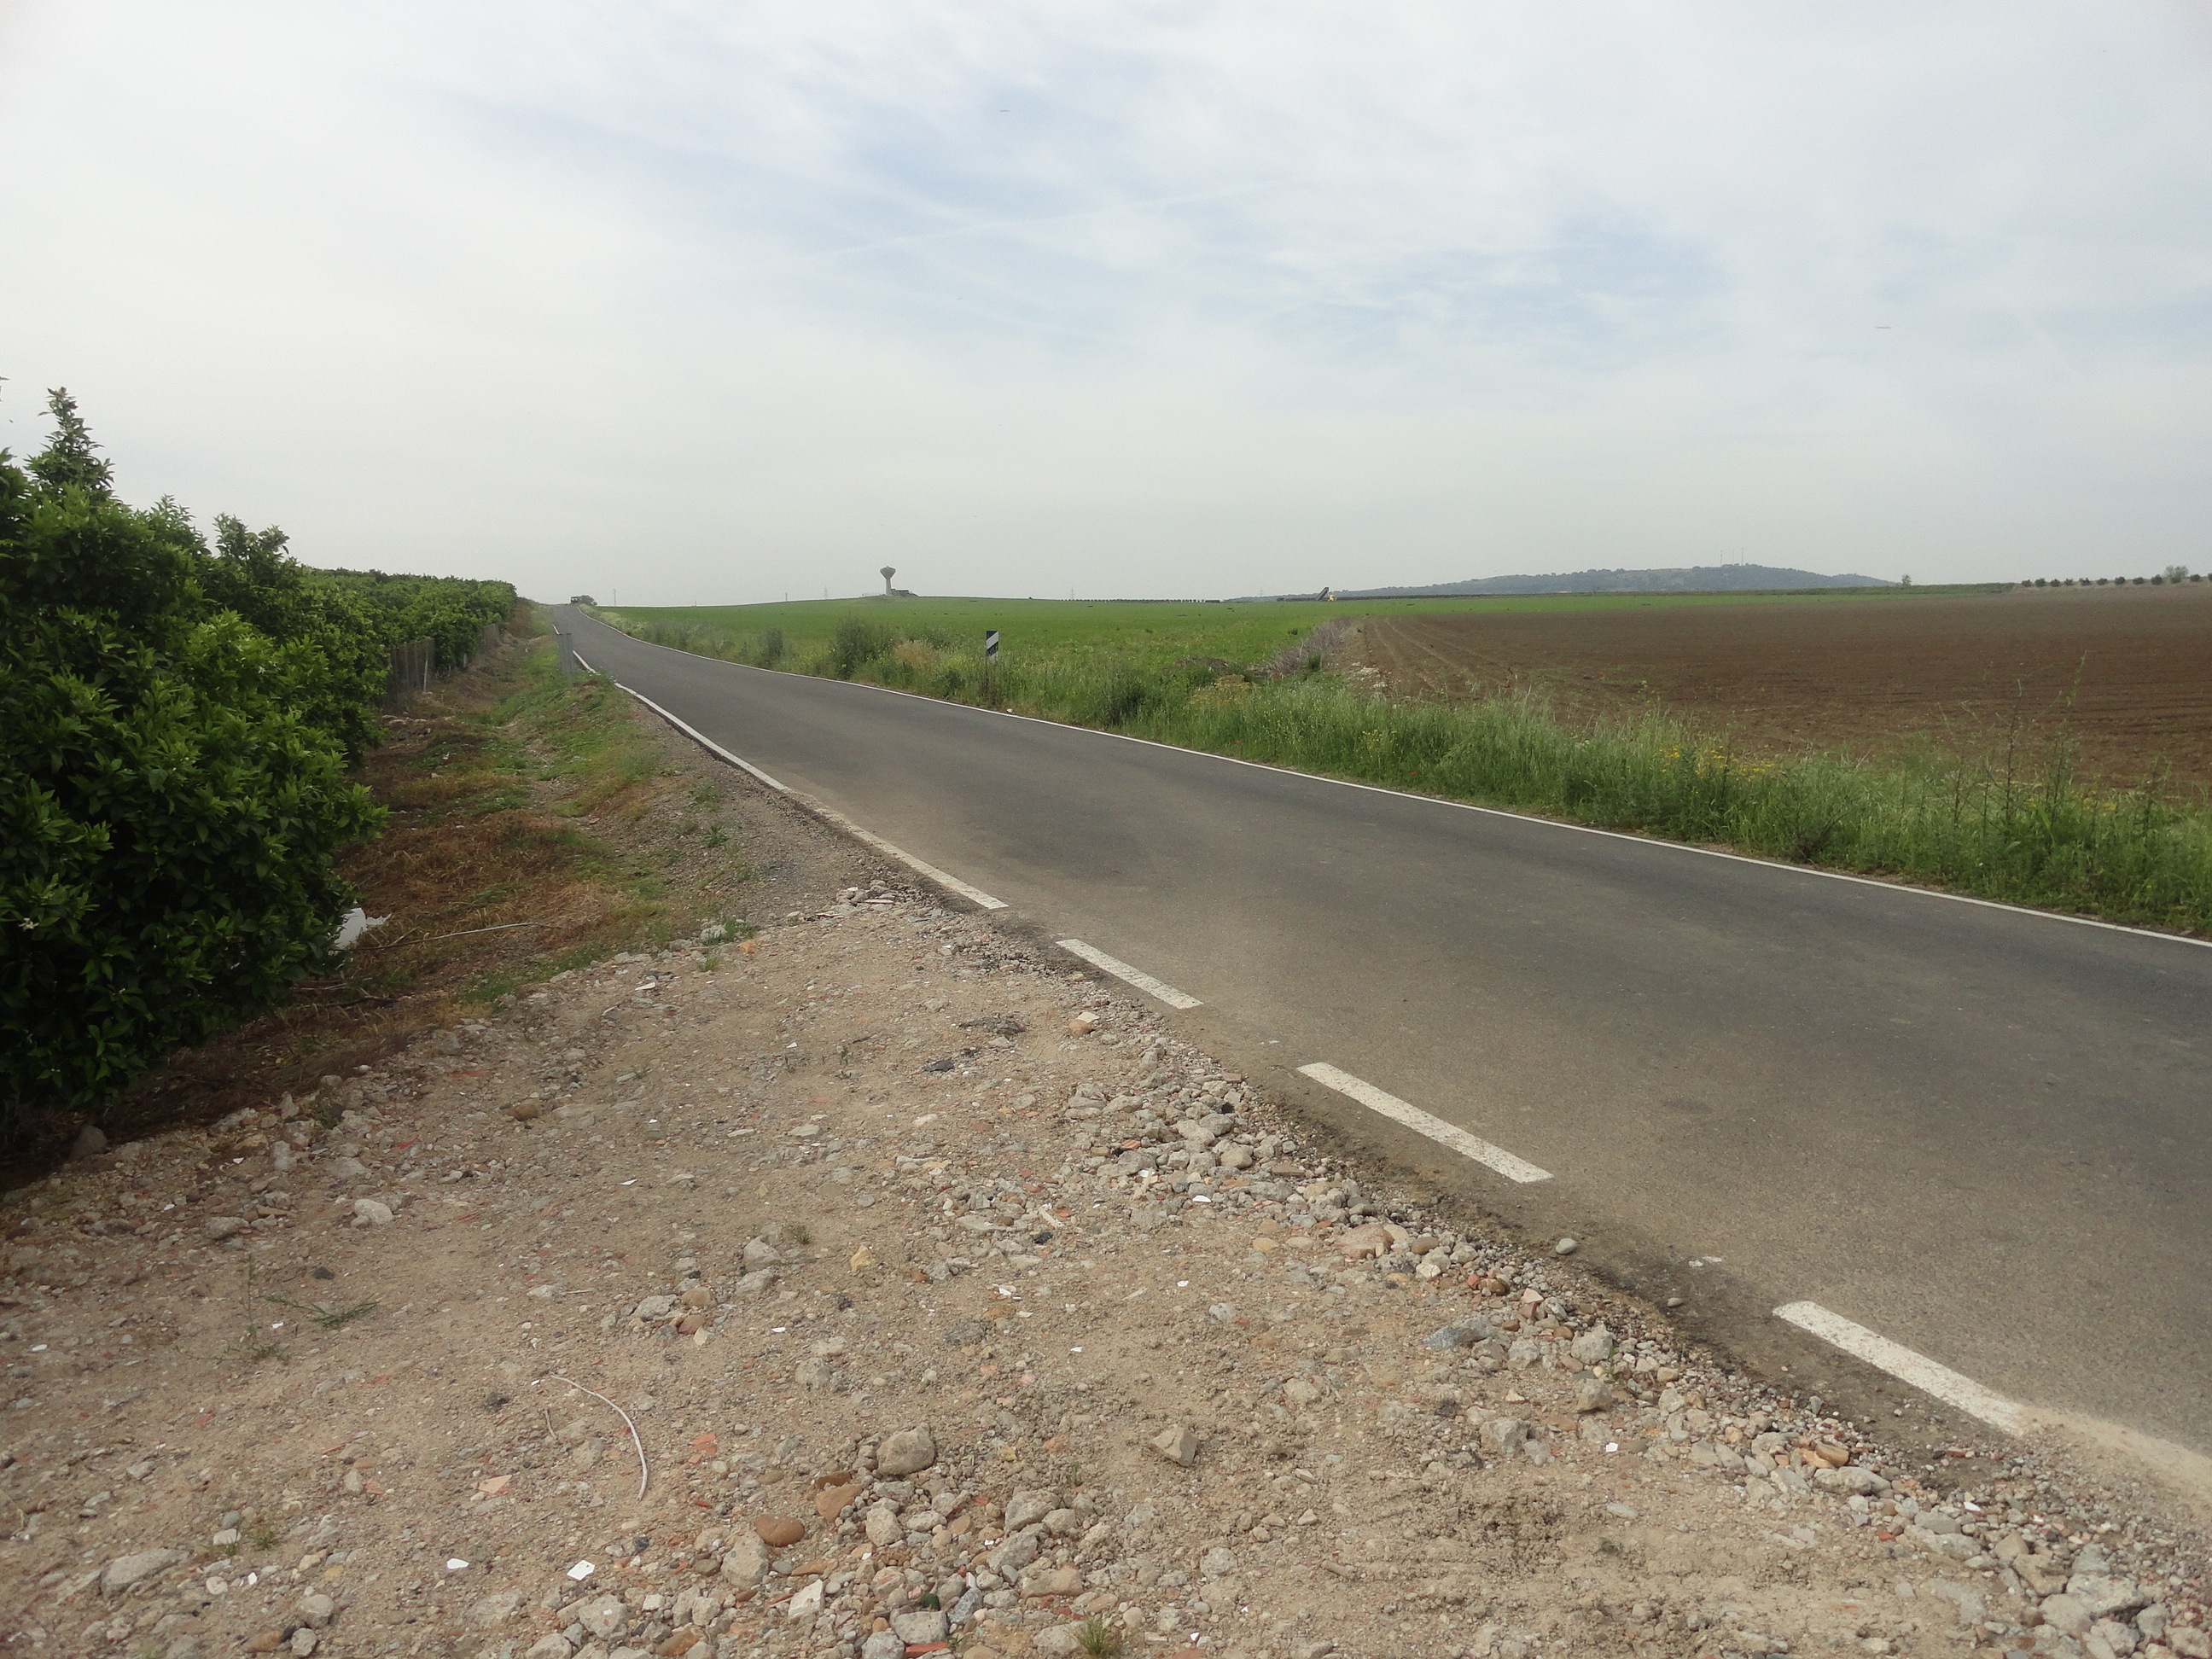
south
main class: Cropland
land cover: Oranges
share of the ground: > 75 %
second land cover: Other bare soil
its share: > 75 %
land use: Agriculture (excluding fallow land and kitchen gardens)
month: April
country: ES
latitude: 37.7808
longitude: -5.2452
